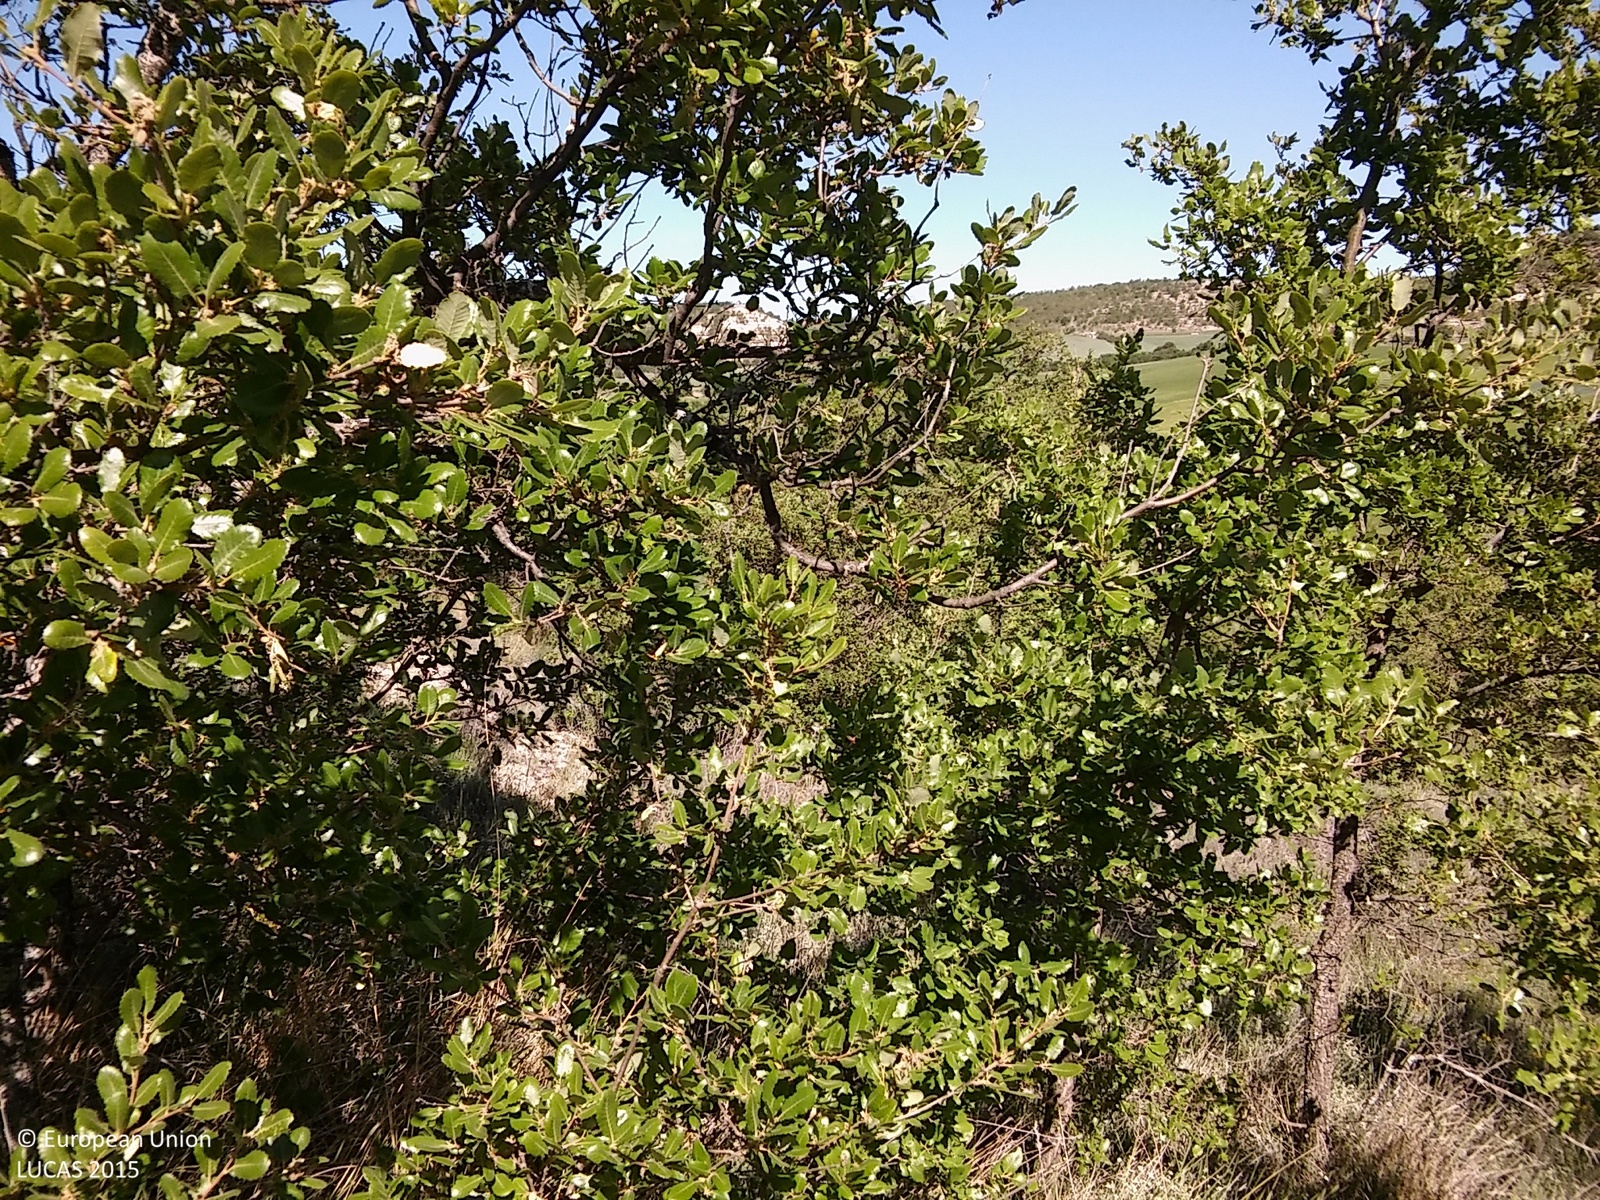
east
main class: Shrubland
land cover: Shrubland with sparse tree cover
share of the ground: 25 - 50 %
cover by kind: shrubs 50 %, unconsolidated bare surface 25 %, herbaceous plants 20 %, broadleaved forest trees 5 %
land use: Semi-natural and natural areas not in use
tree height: > 5 m
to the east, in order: Shrubland with sparse tree cover; Shrubland without tree cover; Broadleaved woodland; Grassland without tree/shrub cover; Barley
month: May
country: ES
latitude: 41.5129
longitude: -3.9903
